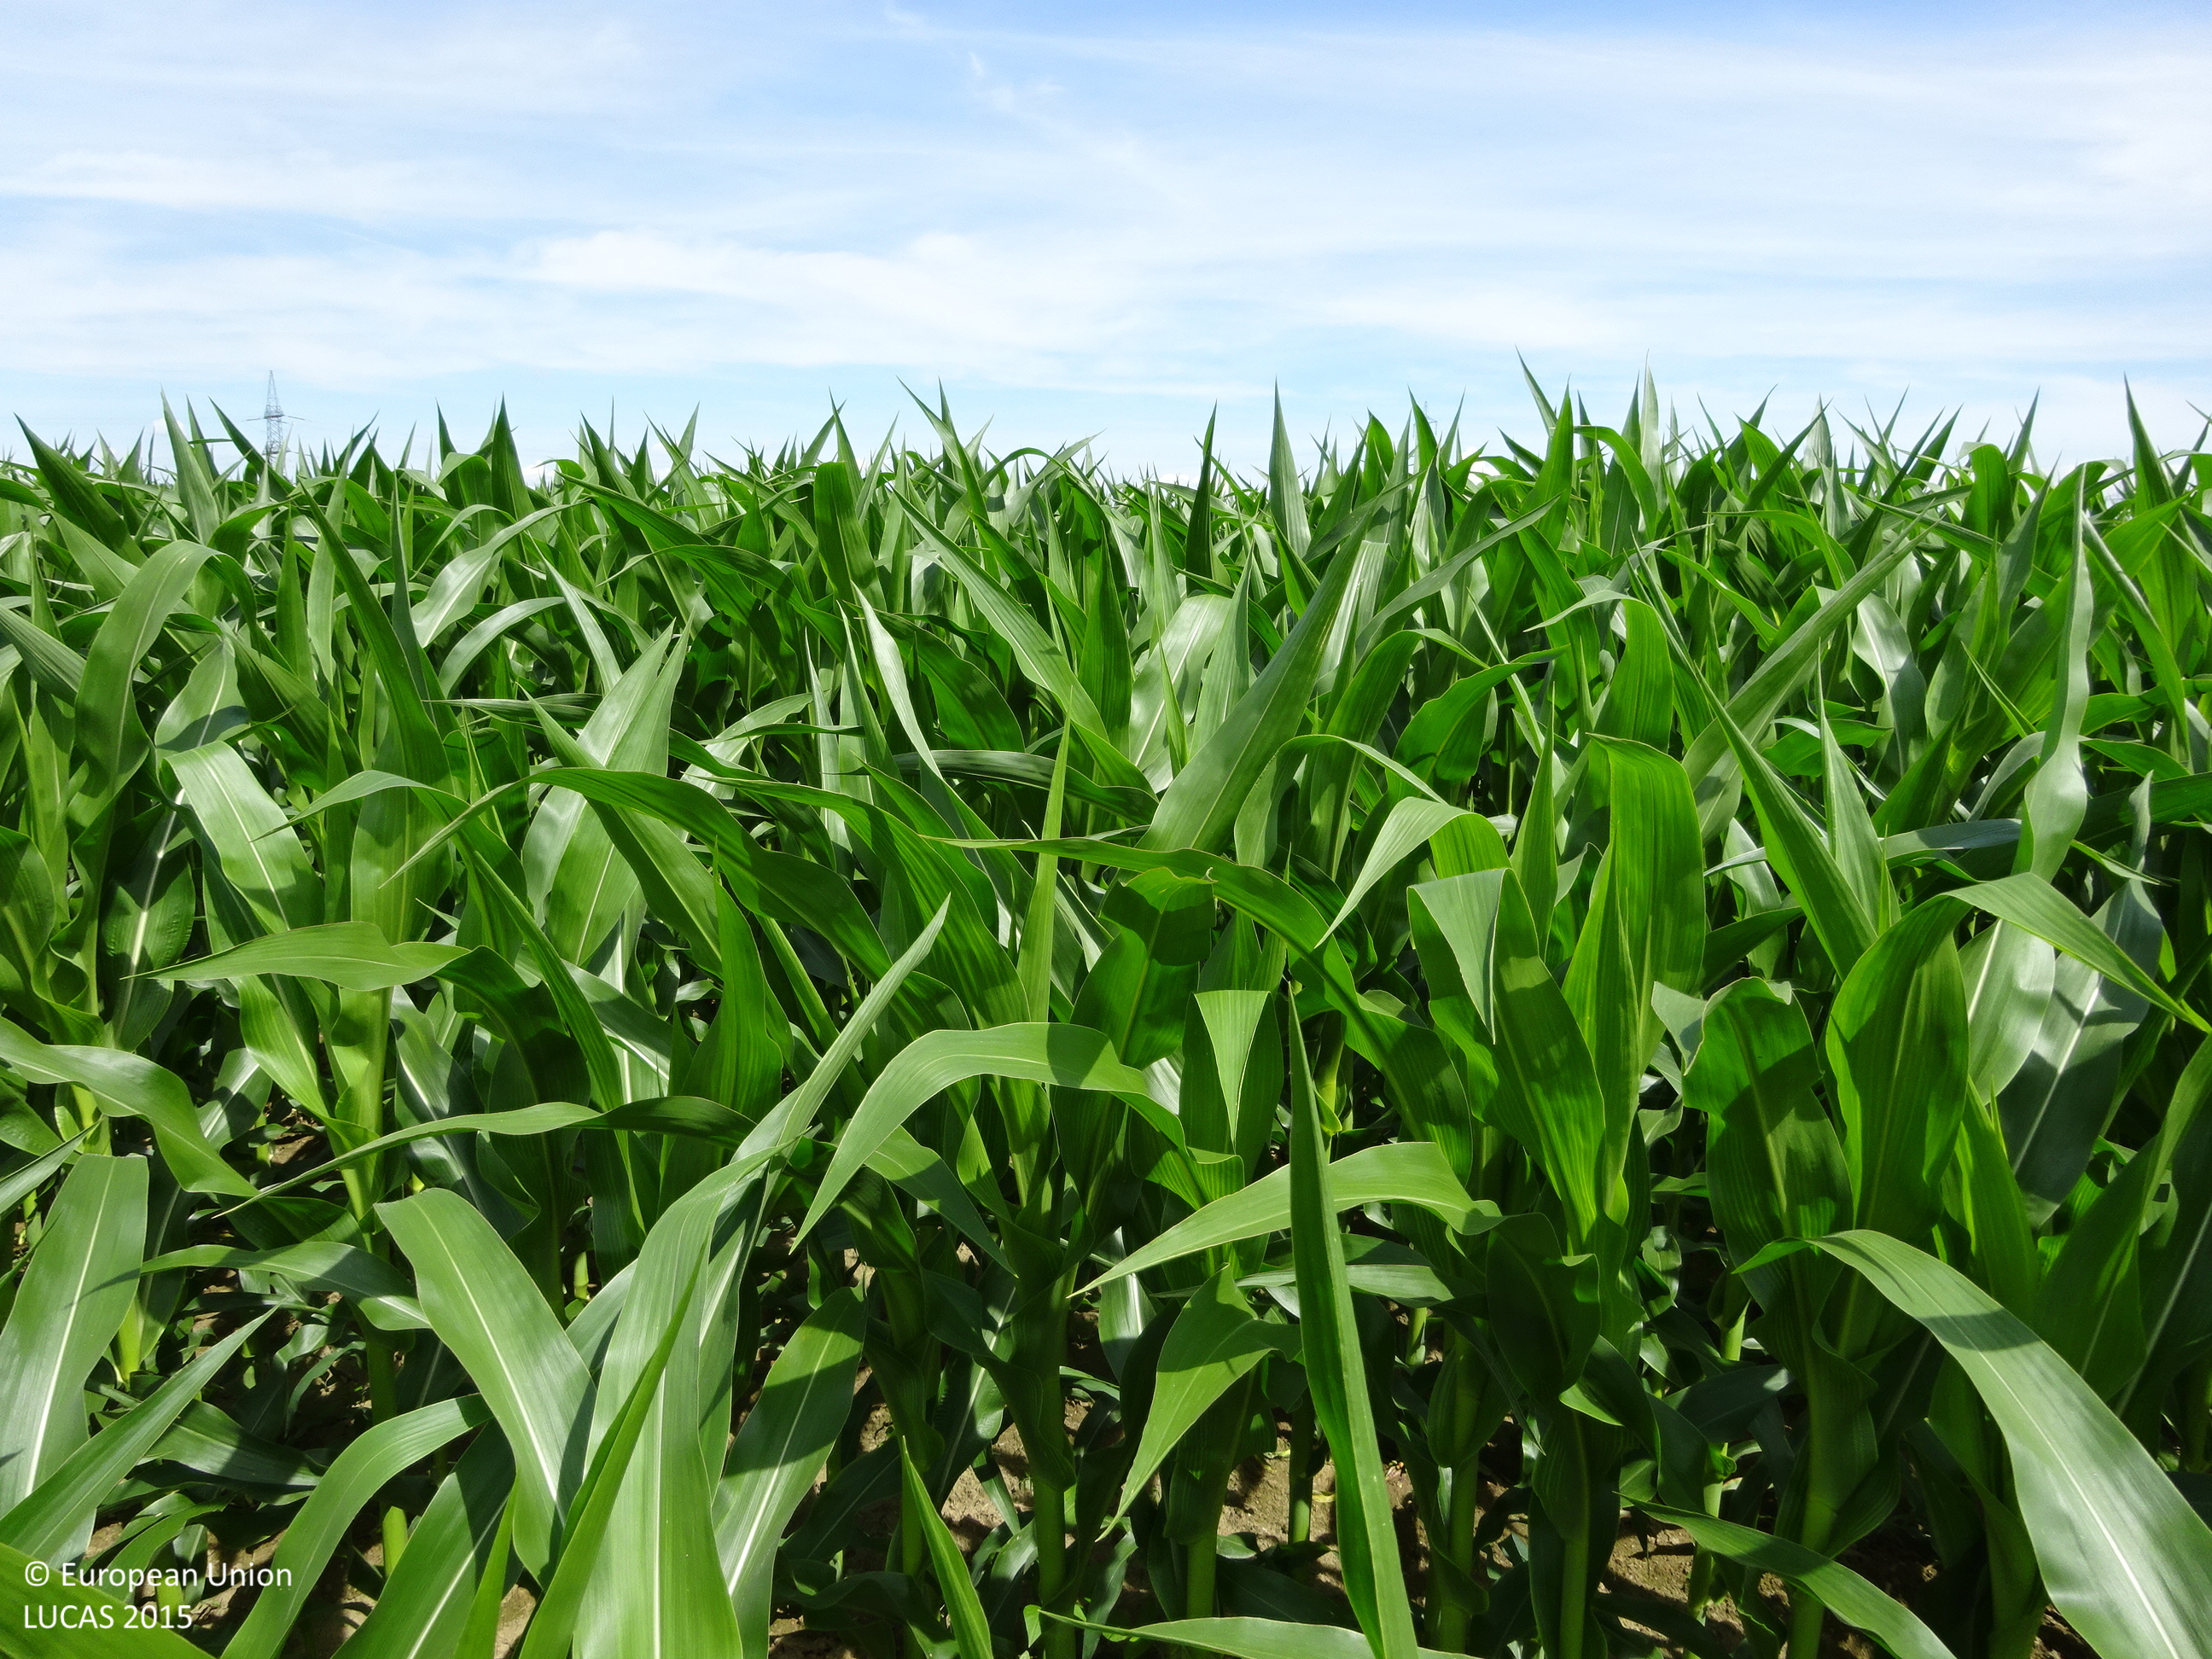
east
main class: Cropland
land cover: Other fibre and oleaginous crops
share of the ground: > 75 %
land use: Agriculture (excluding fallow land and kitchen gardens)
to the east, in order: Other fibre and oleaginous crops; Maize; Paved roads, cycling and walking lanes; Grass margins; Maize; Tracks; Grass margins; Maize; Other fibre and oleaginous crops; Maize
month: June
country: AT
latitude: 46.7439
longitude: 15.6408
